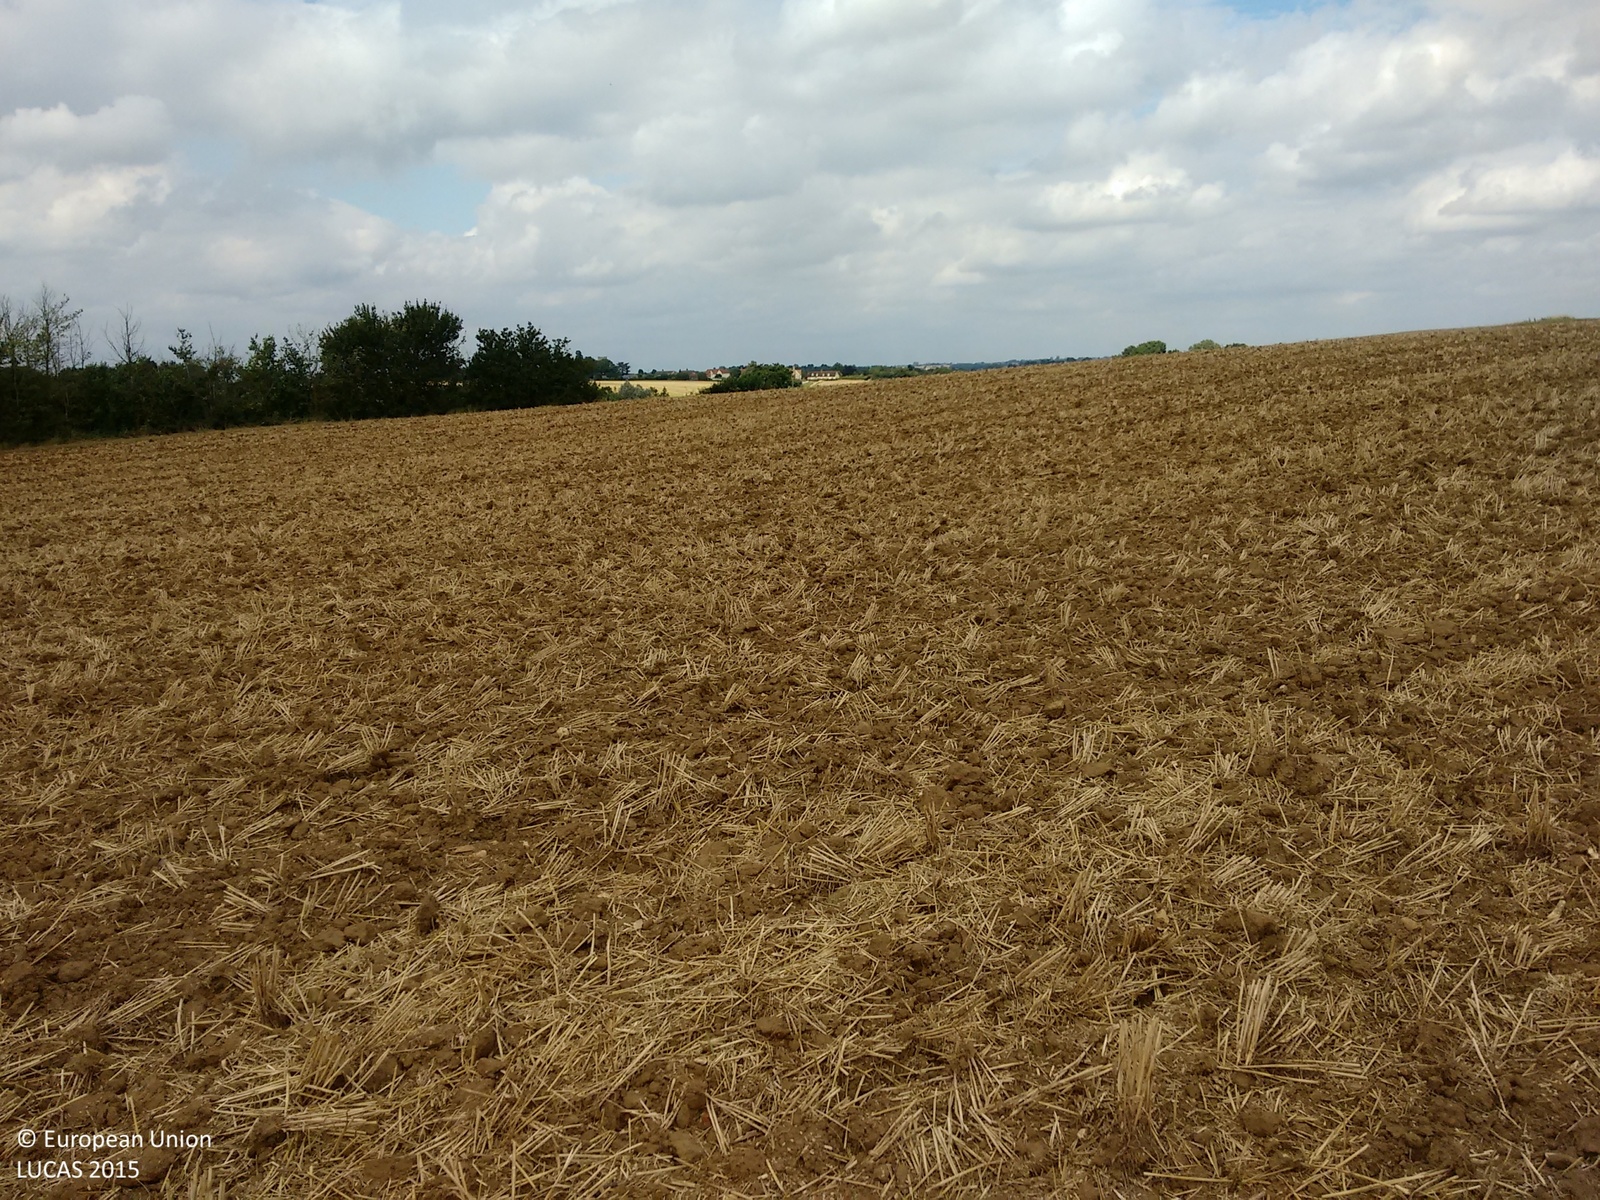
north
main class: Cropland
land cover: Common wheat
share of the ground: 25 - 50 %
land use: Agriculture (excluding fallow land and kitchen gardens)
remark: Harvested field
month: August
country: GB
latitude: 52.0471
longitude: 0.9212
